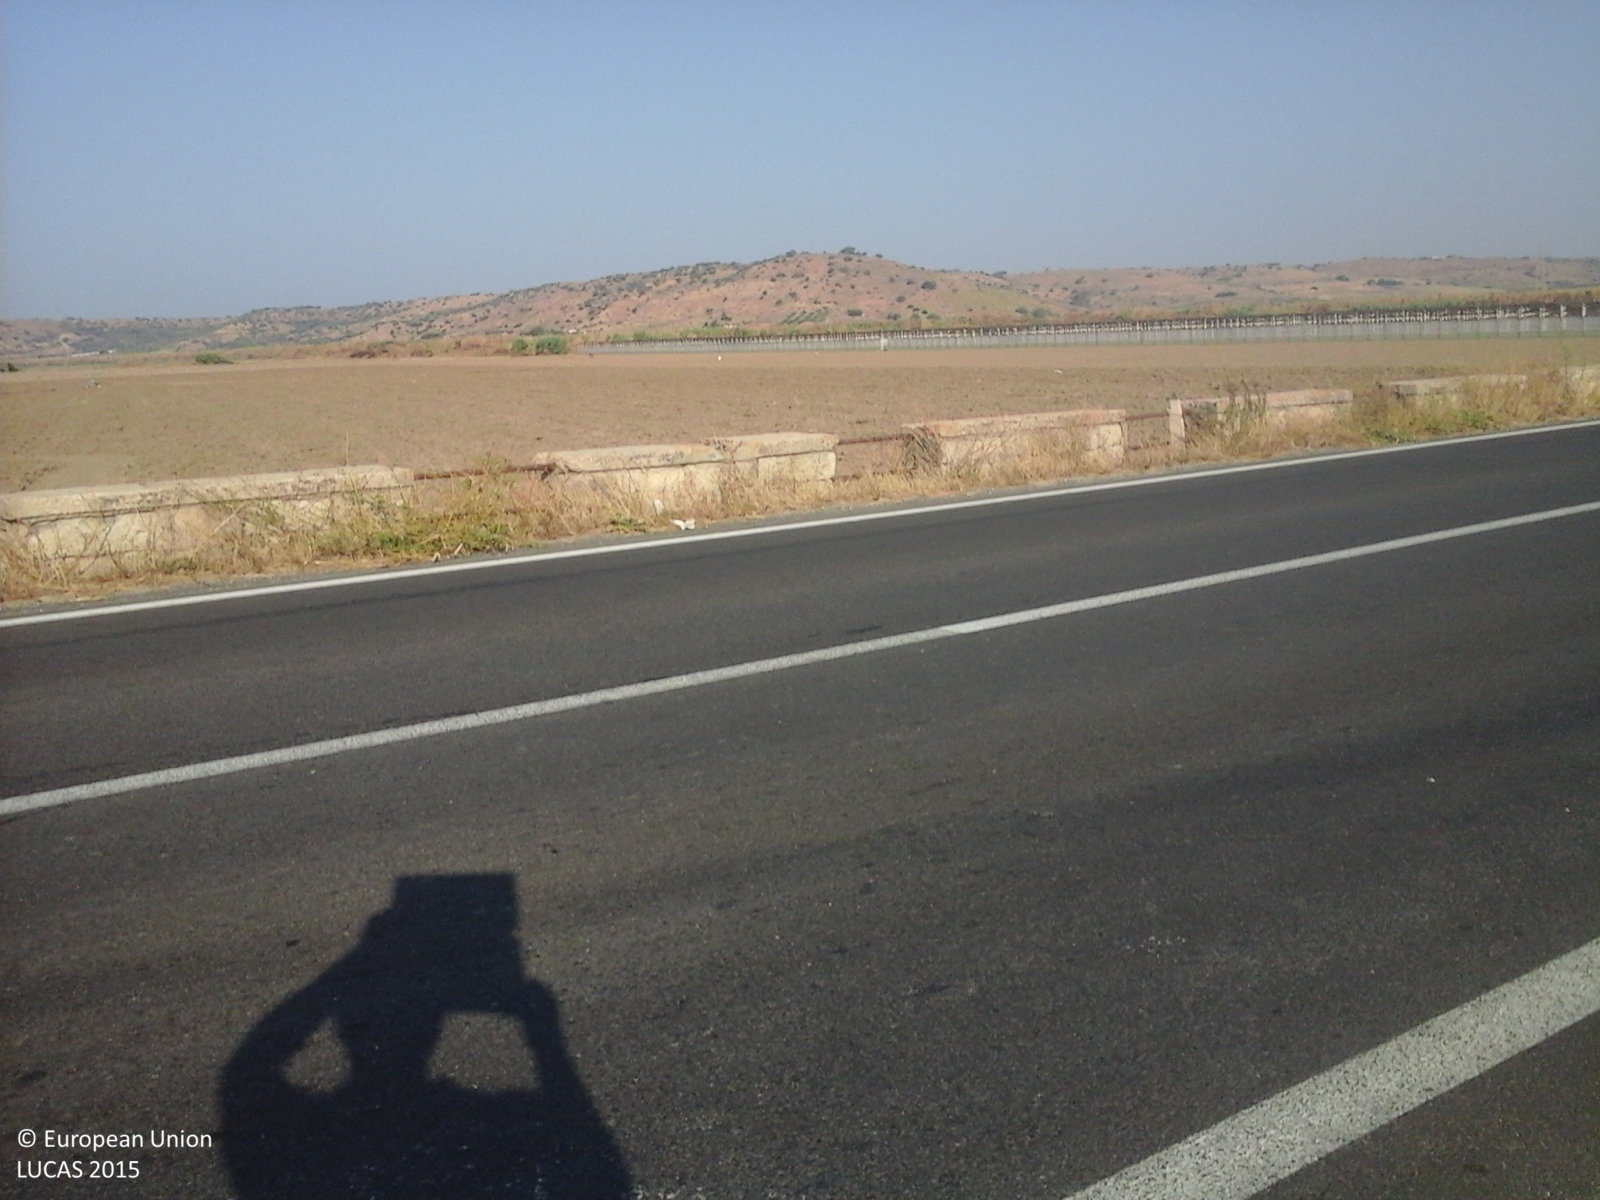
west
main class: Cropland
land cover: Durum wheat
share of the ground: > 75 %
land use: Agriculture (excluding fallow land and kitchen gardens)
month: July
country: IT
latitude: 37.0272
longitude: 14.4053
